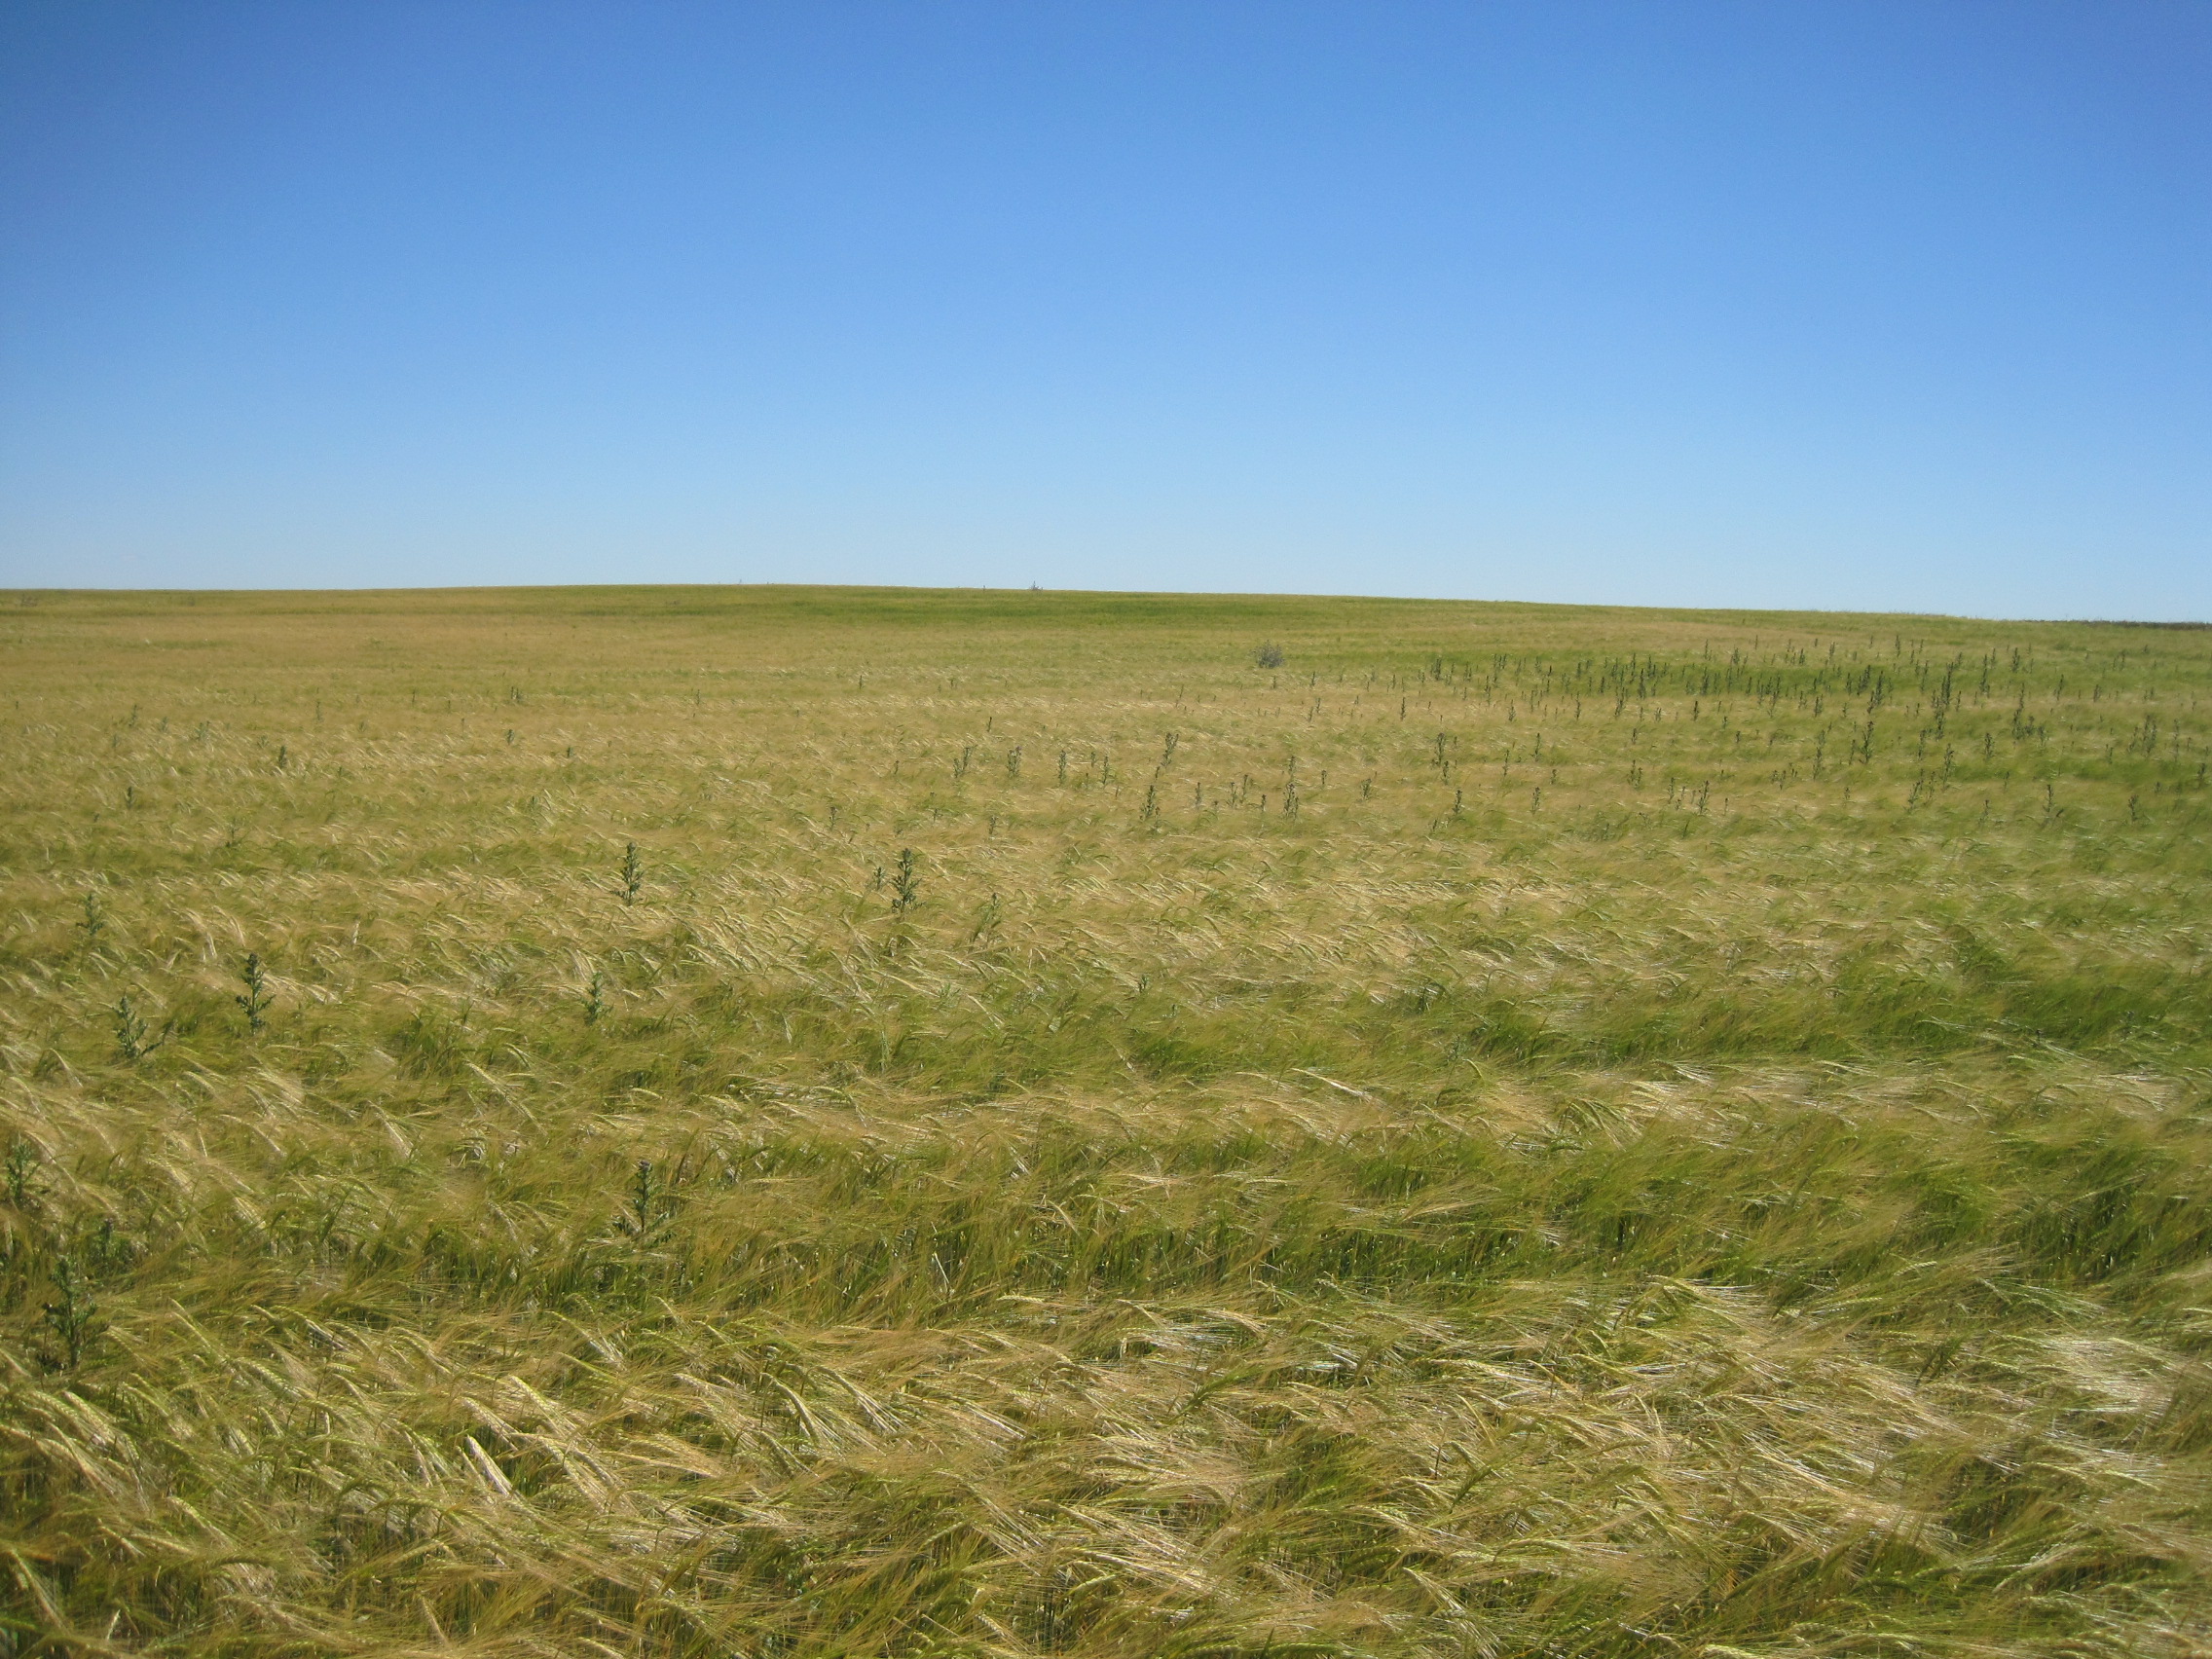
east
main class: Cropland
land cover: Barley
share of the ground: > 75 %
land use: Agriculture (excluding fallow land and kitchen gardens)
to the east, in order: Barley
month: May
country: ES
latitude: 41.2822
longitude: -5.2976
